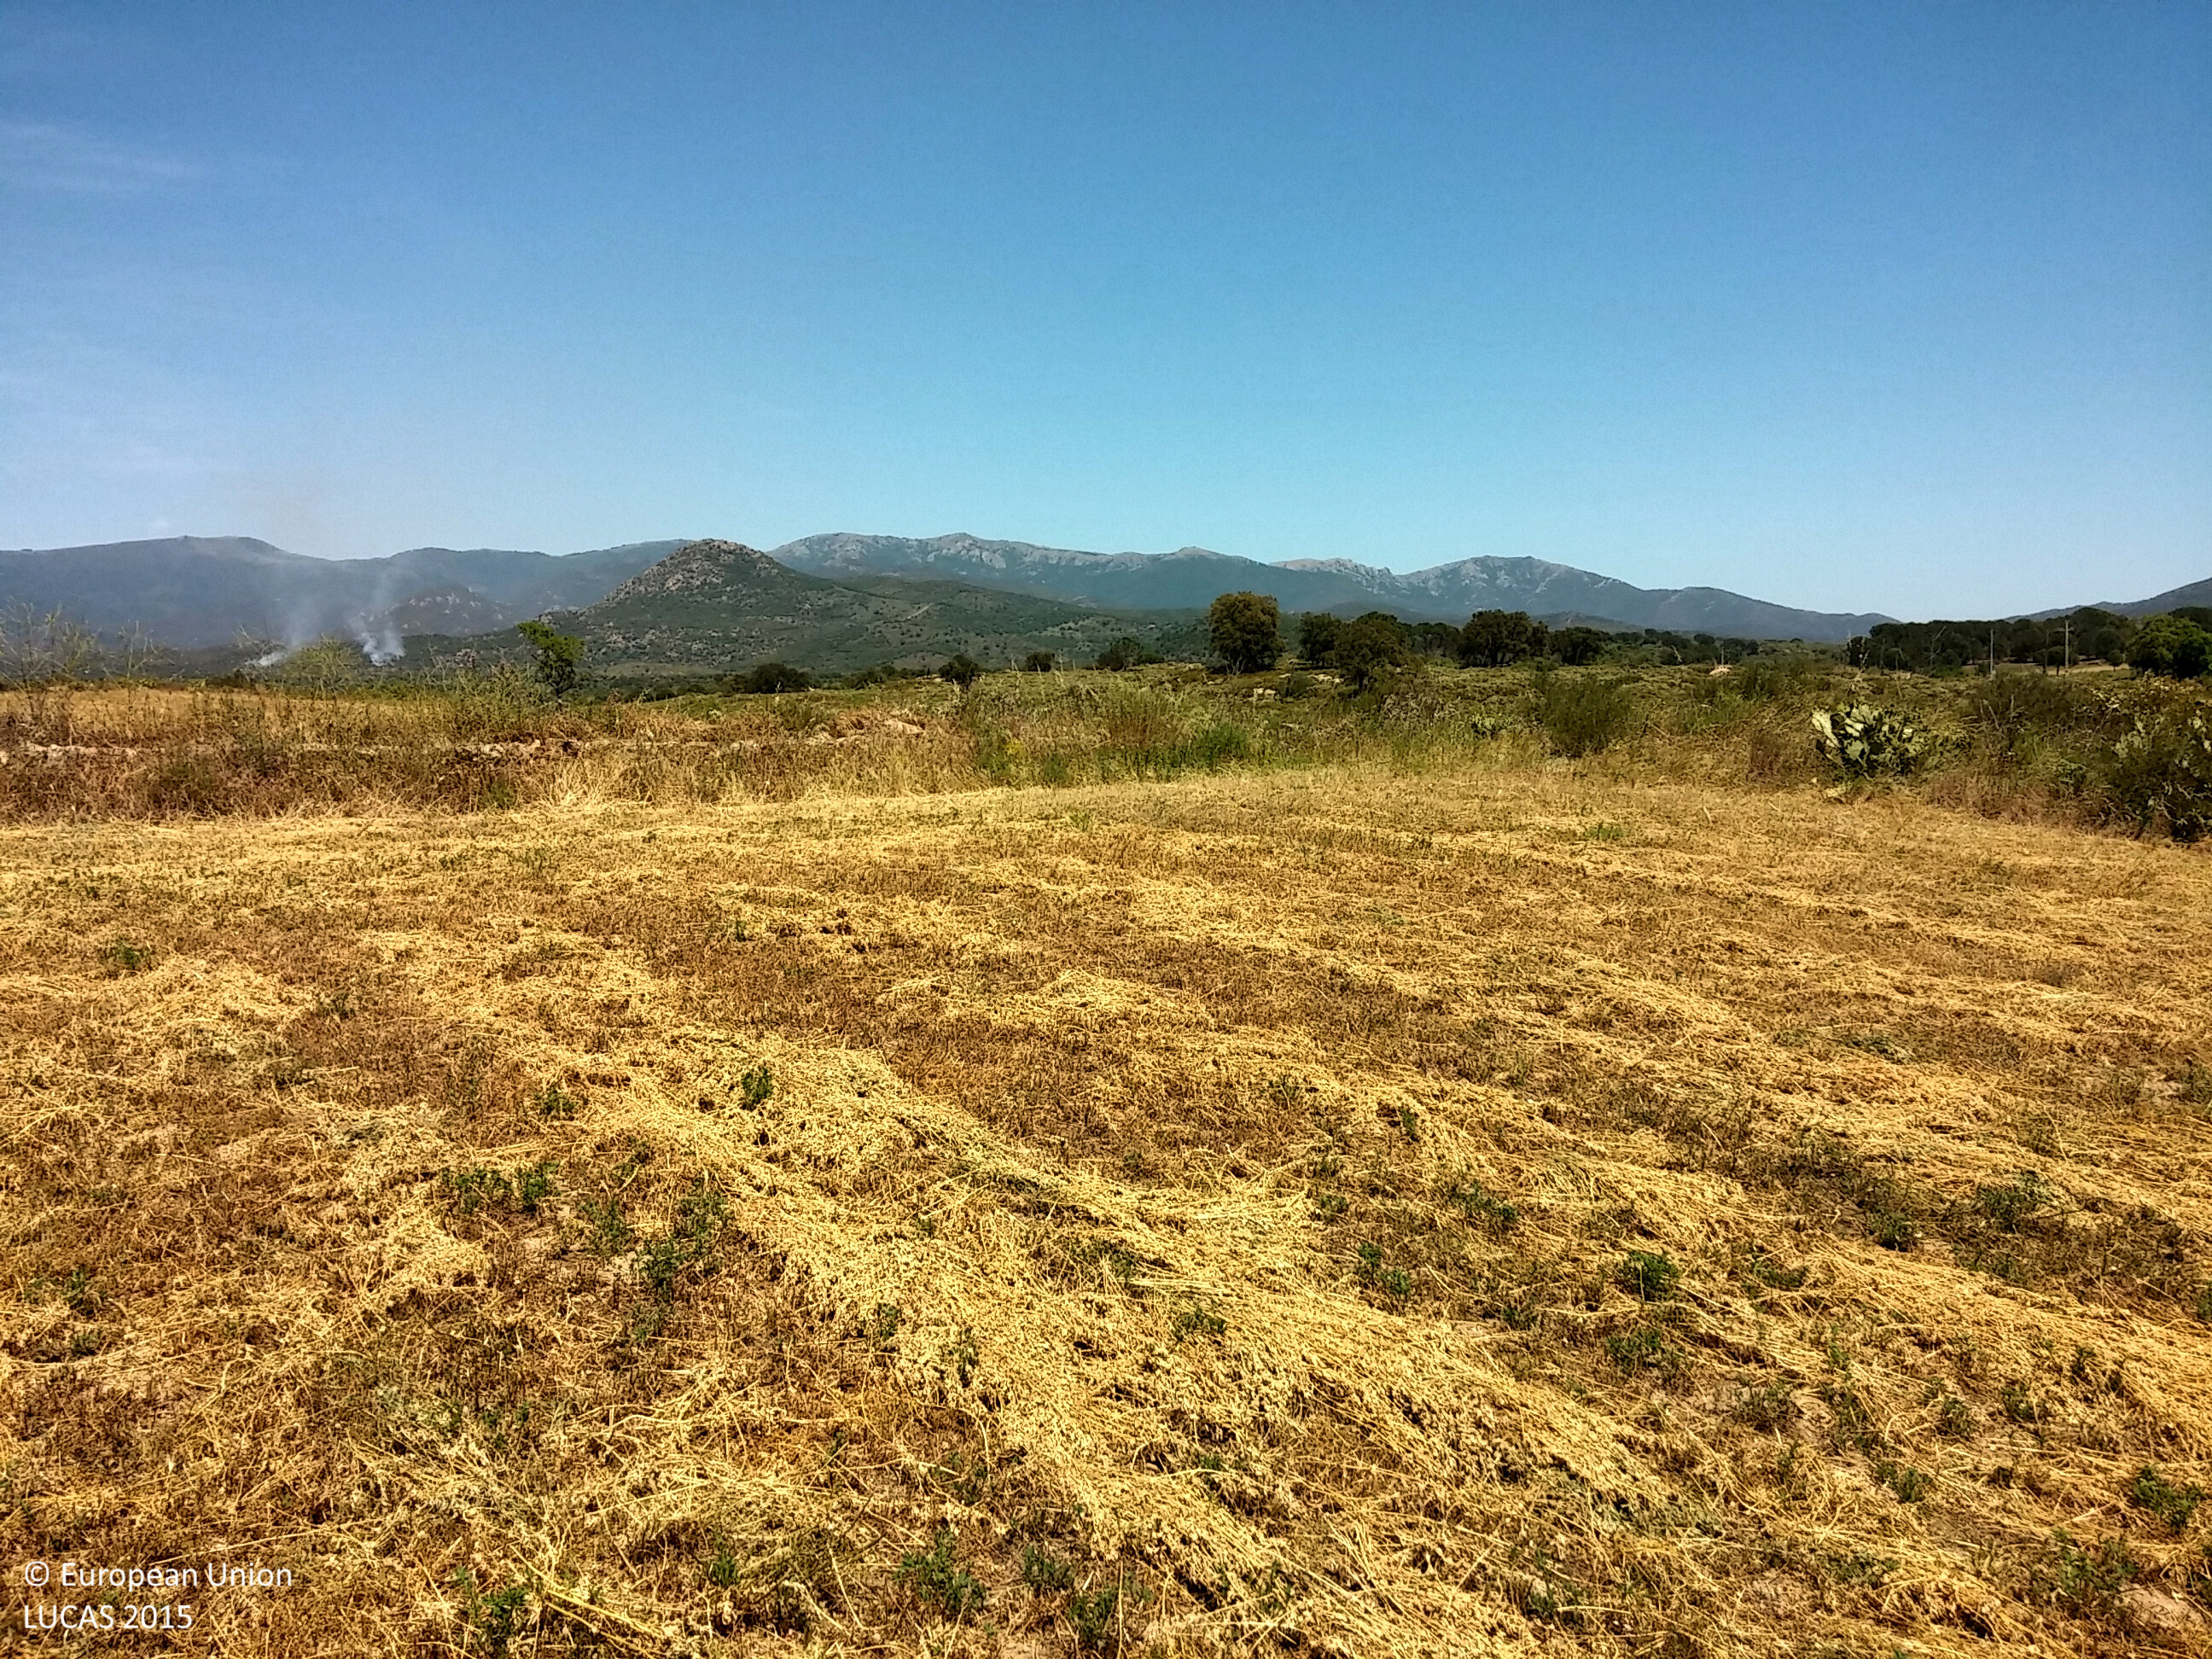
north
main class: Cropland
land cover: Lucerne
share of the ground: > 75 %
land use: Agriculture (excluding fallow land and kitchen gardens)
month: May
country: ES
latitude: 42.3742
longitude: 2.9822
